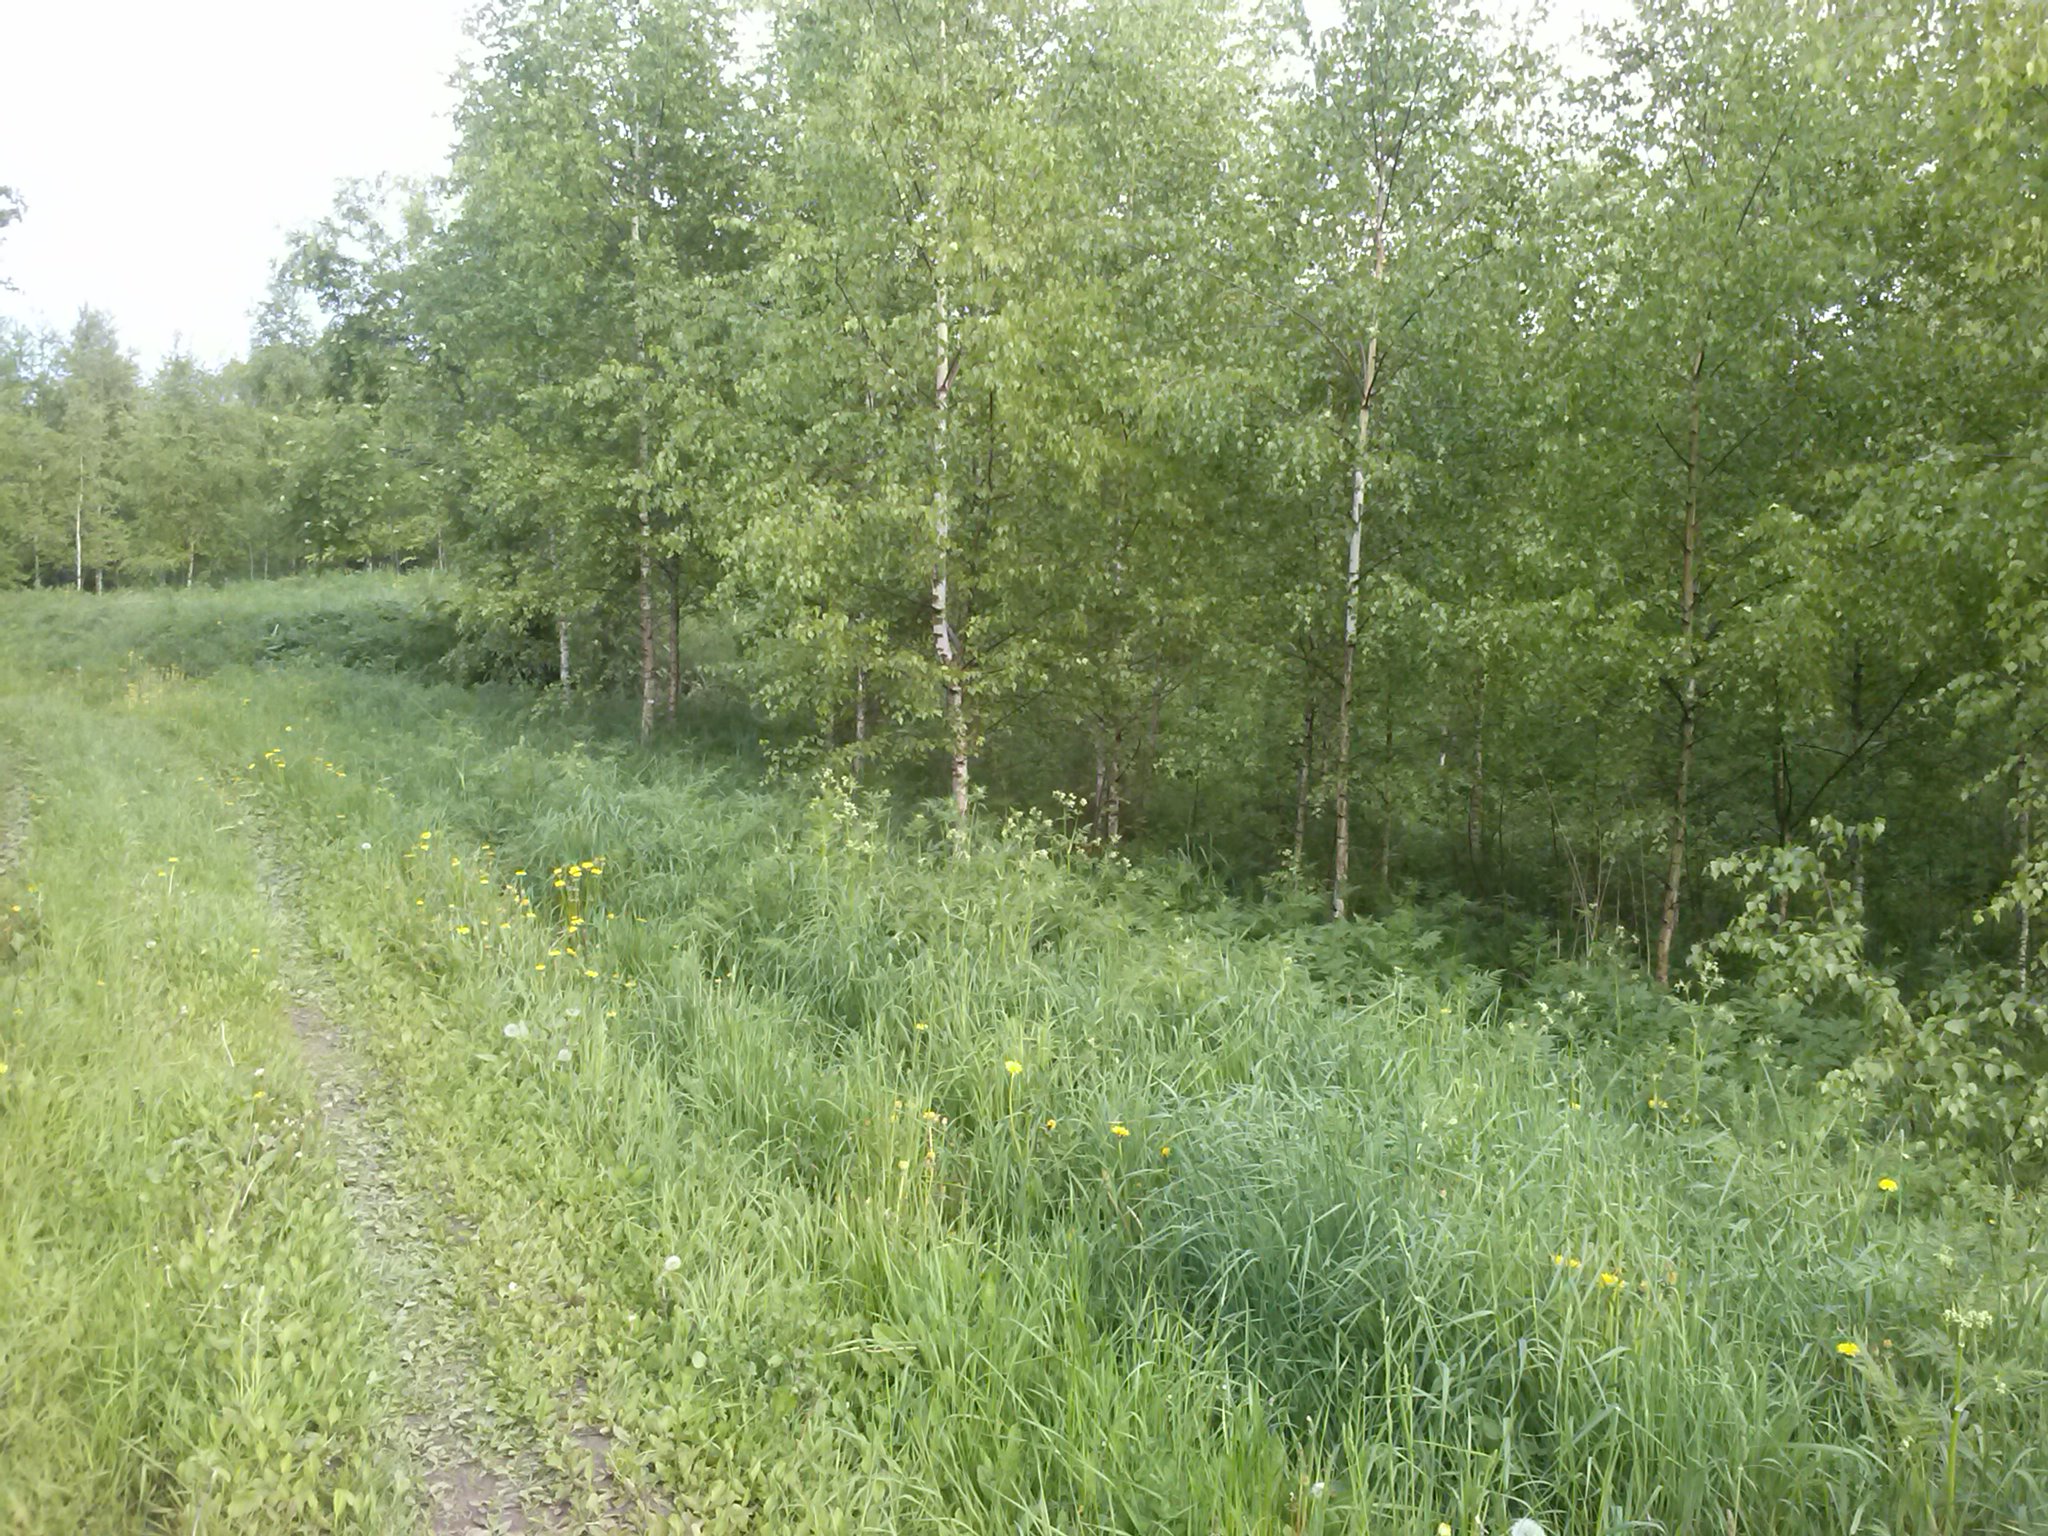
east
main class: Grassland
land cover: Spontaneously vegetated surfaces
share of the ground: > 75 %
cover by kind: herbaceous plants 100 %
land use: Semi-natural and natural areas not in use
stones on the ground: < 10 %
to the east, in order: Spontaneously vegetated surfaces; Broadleaved woodland; Grassland without tree/shrub cover; Tracks; Grassland without tree/shrub cover; Grassland with sparse tree/shrub cover; Artificial constructions in urban areas
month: May
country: LV
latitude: 56.2963
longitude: 27.7869
